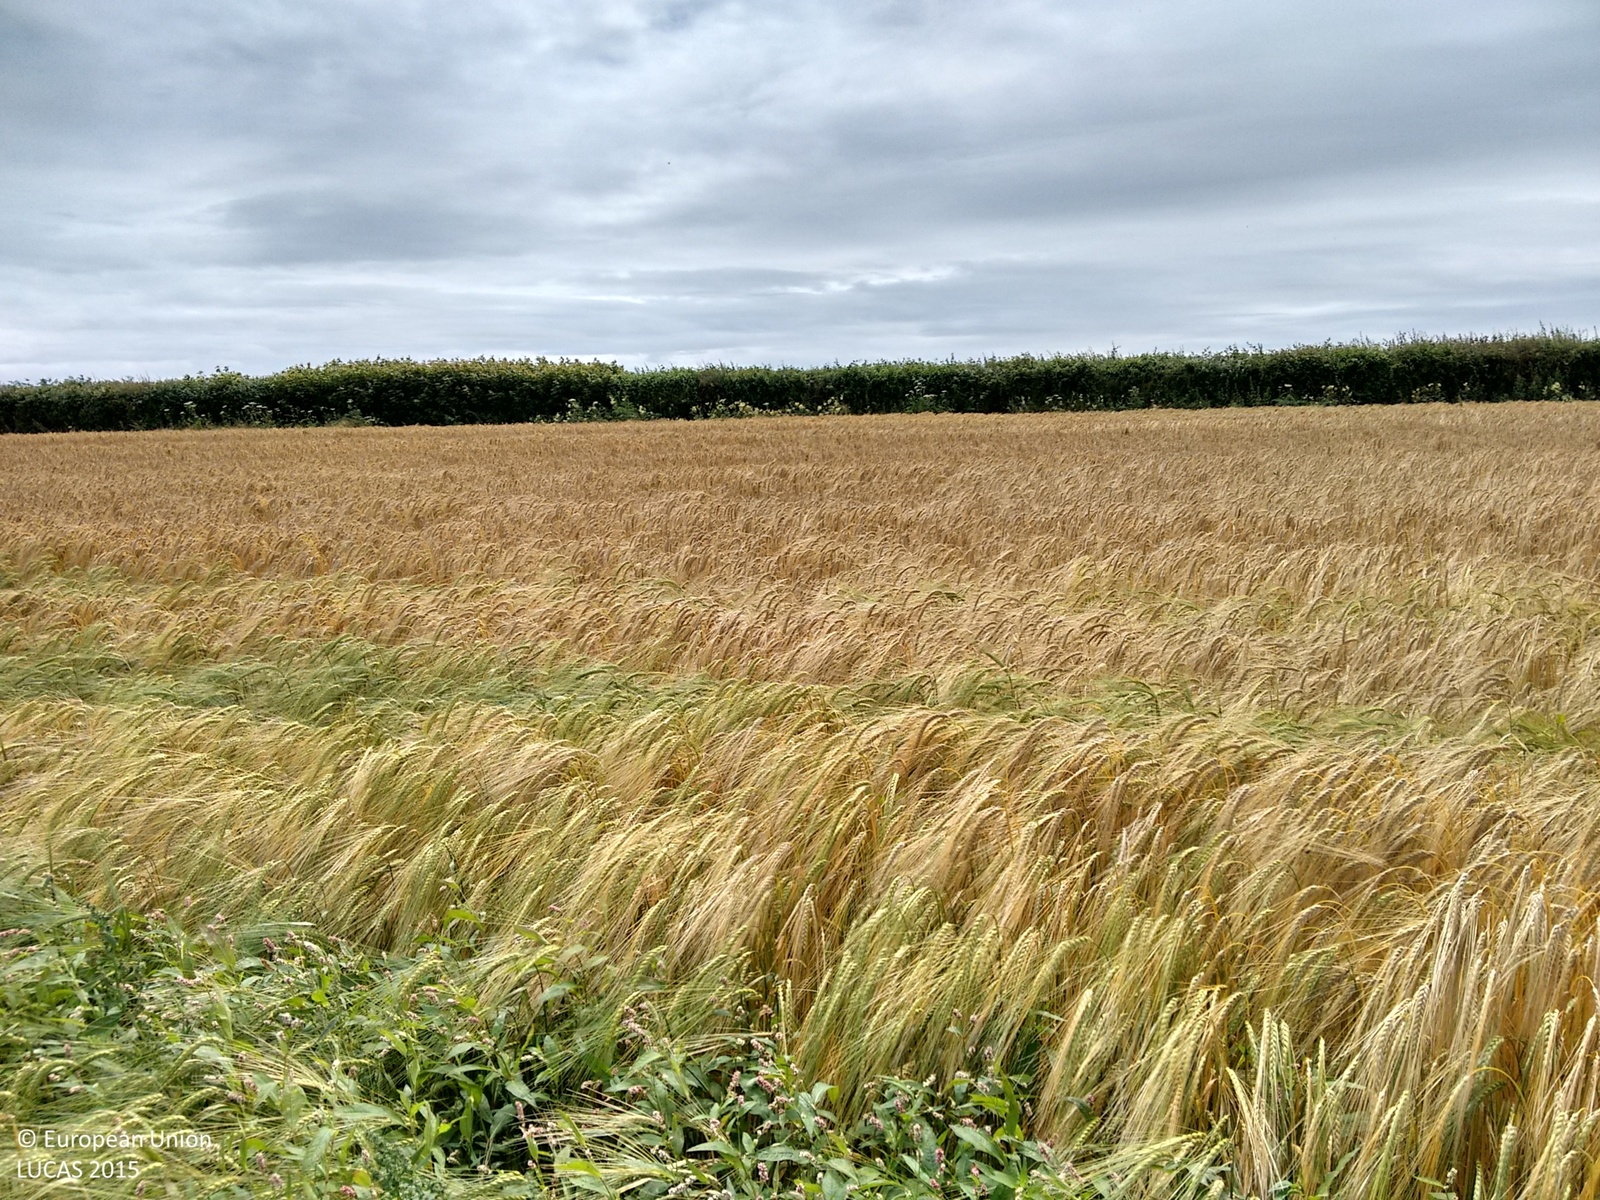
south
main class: Cropland
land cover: Barley
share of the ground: > 75 %
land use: Agriculture (excluding fallow land and kitchen gardens)
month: July
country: GB
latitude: 51.4334
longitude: -3.5346
